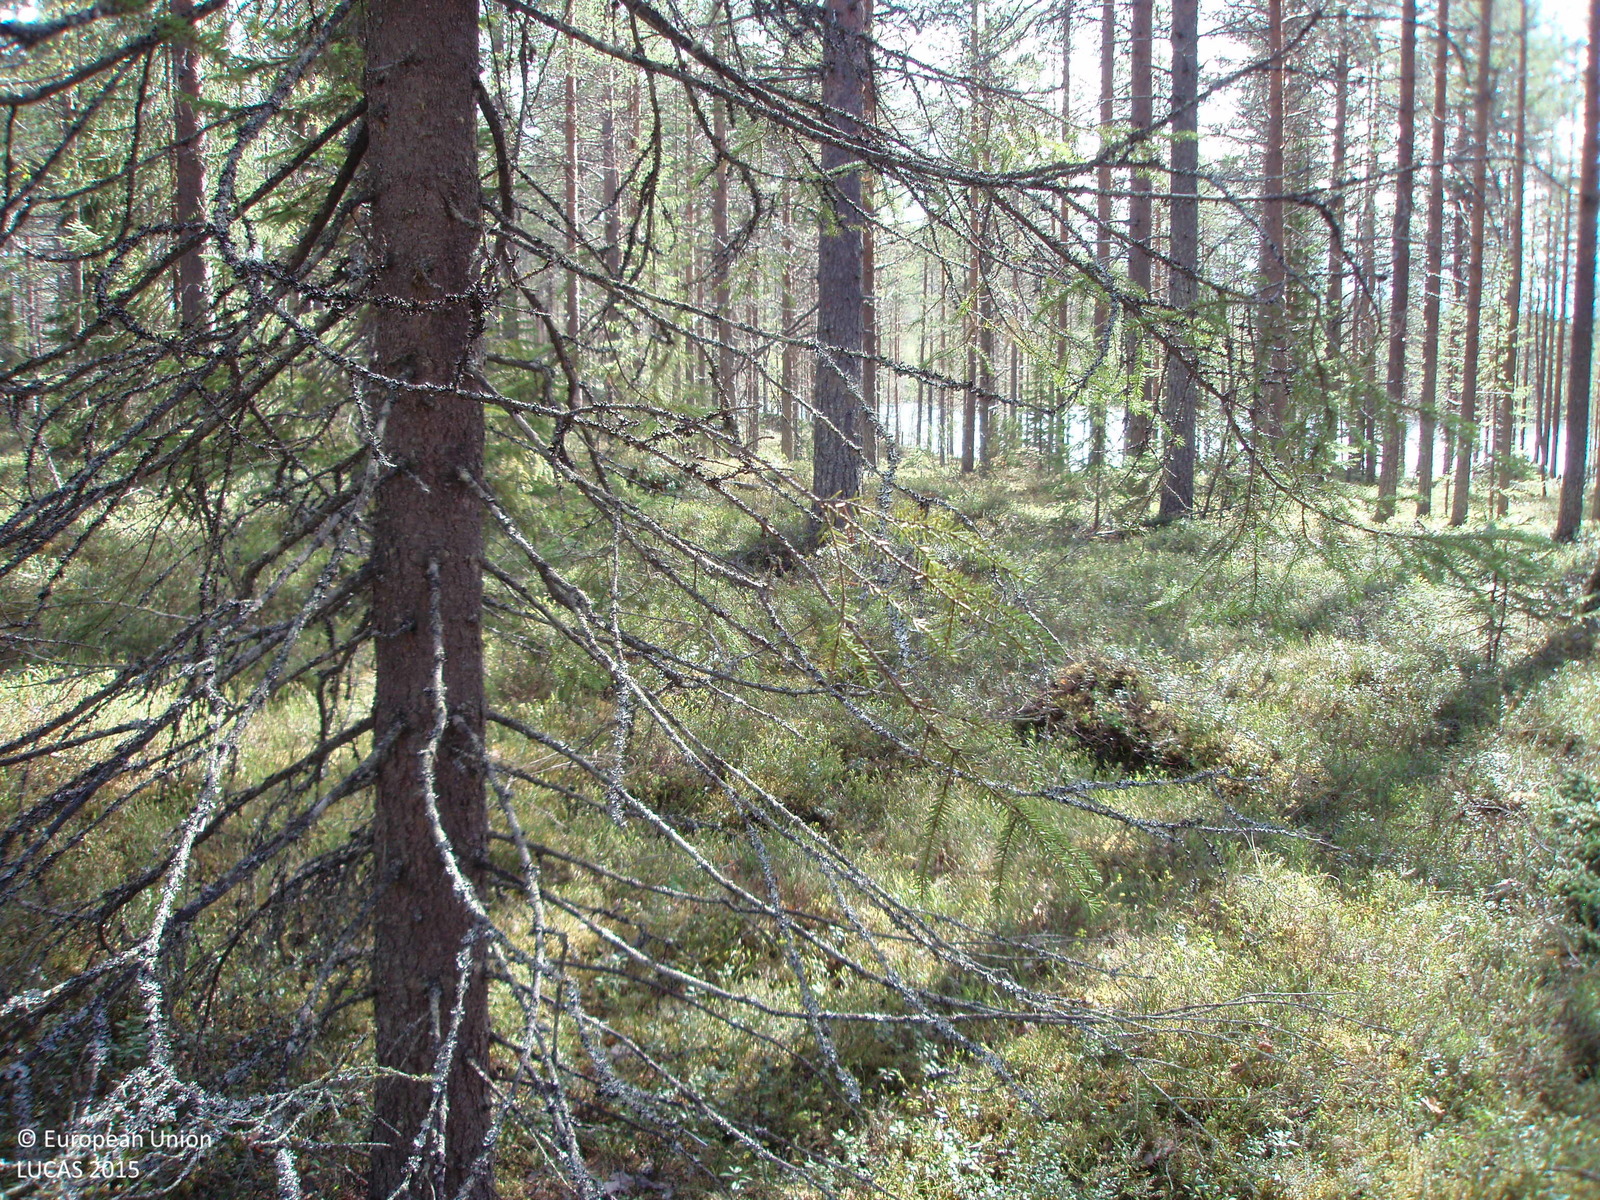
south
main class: Woodland
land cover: Pine dominated coniferous woodland
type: boreal forest
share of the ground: > 75 %
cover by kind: coniferous forest trees 75 %, shrubs 20 %, lichens and mosses 5 %
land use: Forestry
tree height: > 5 m
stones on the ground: < 10 %
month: June
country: FI
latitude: 66.7270
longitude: 26.9934
